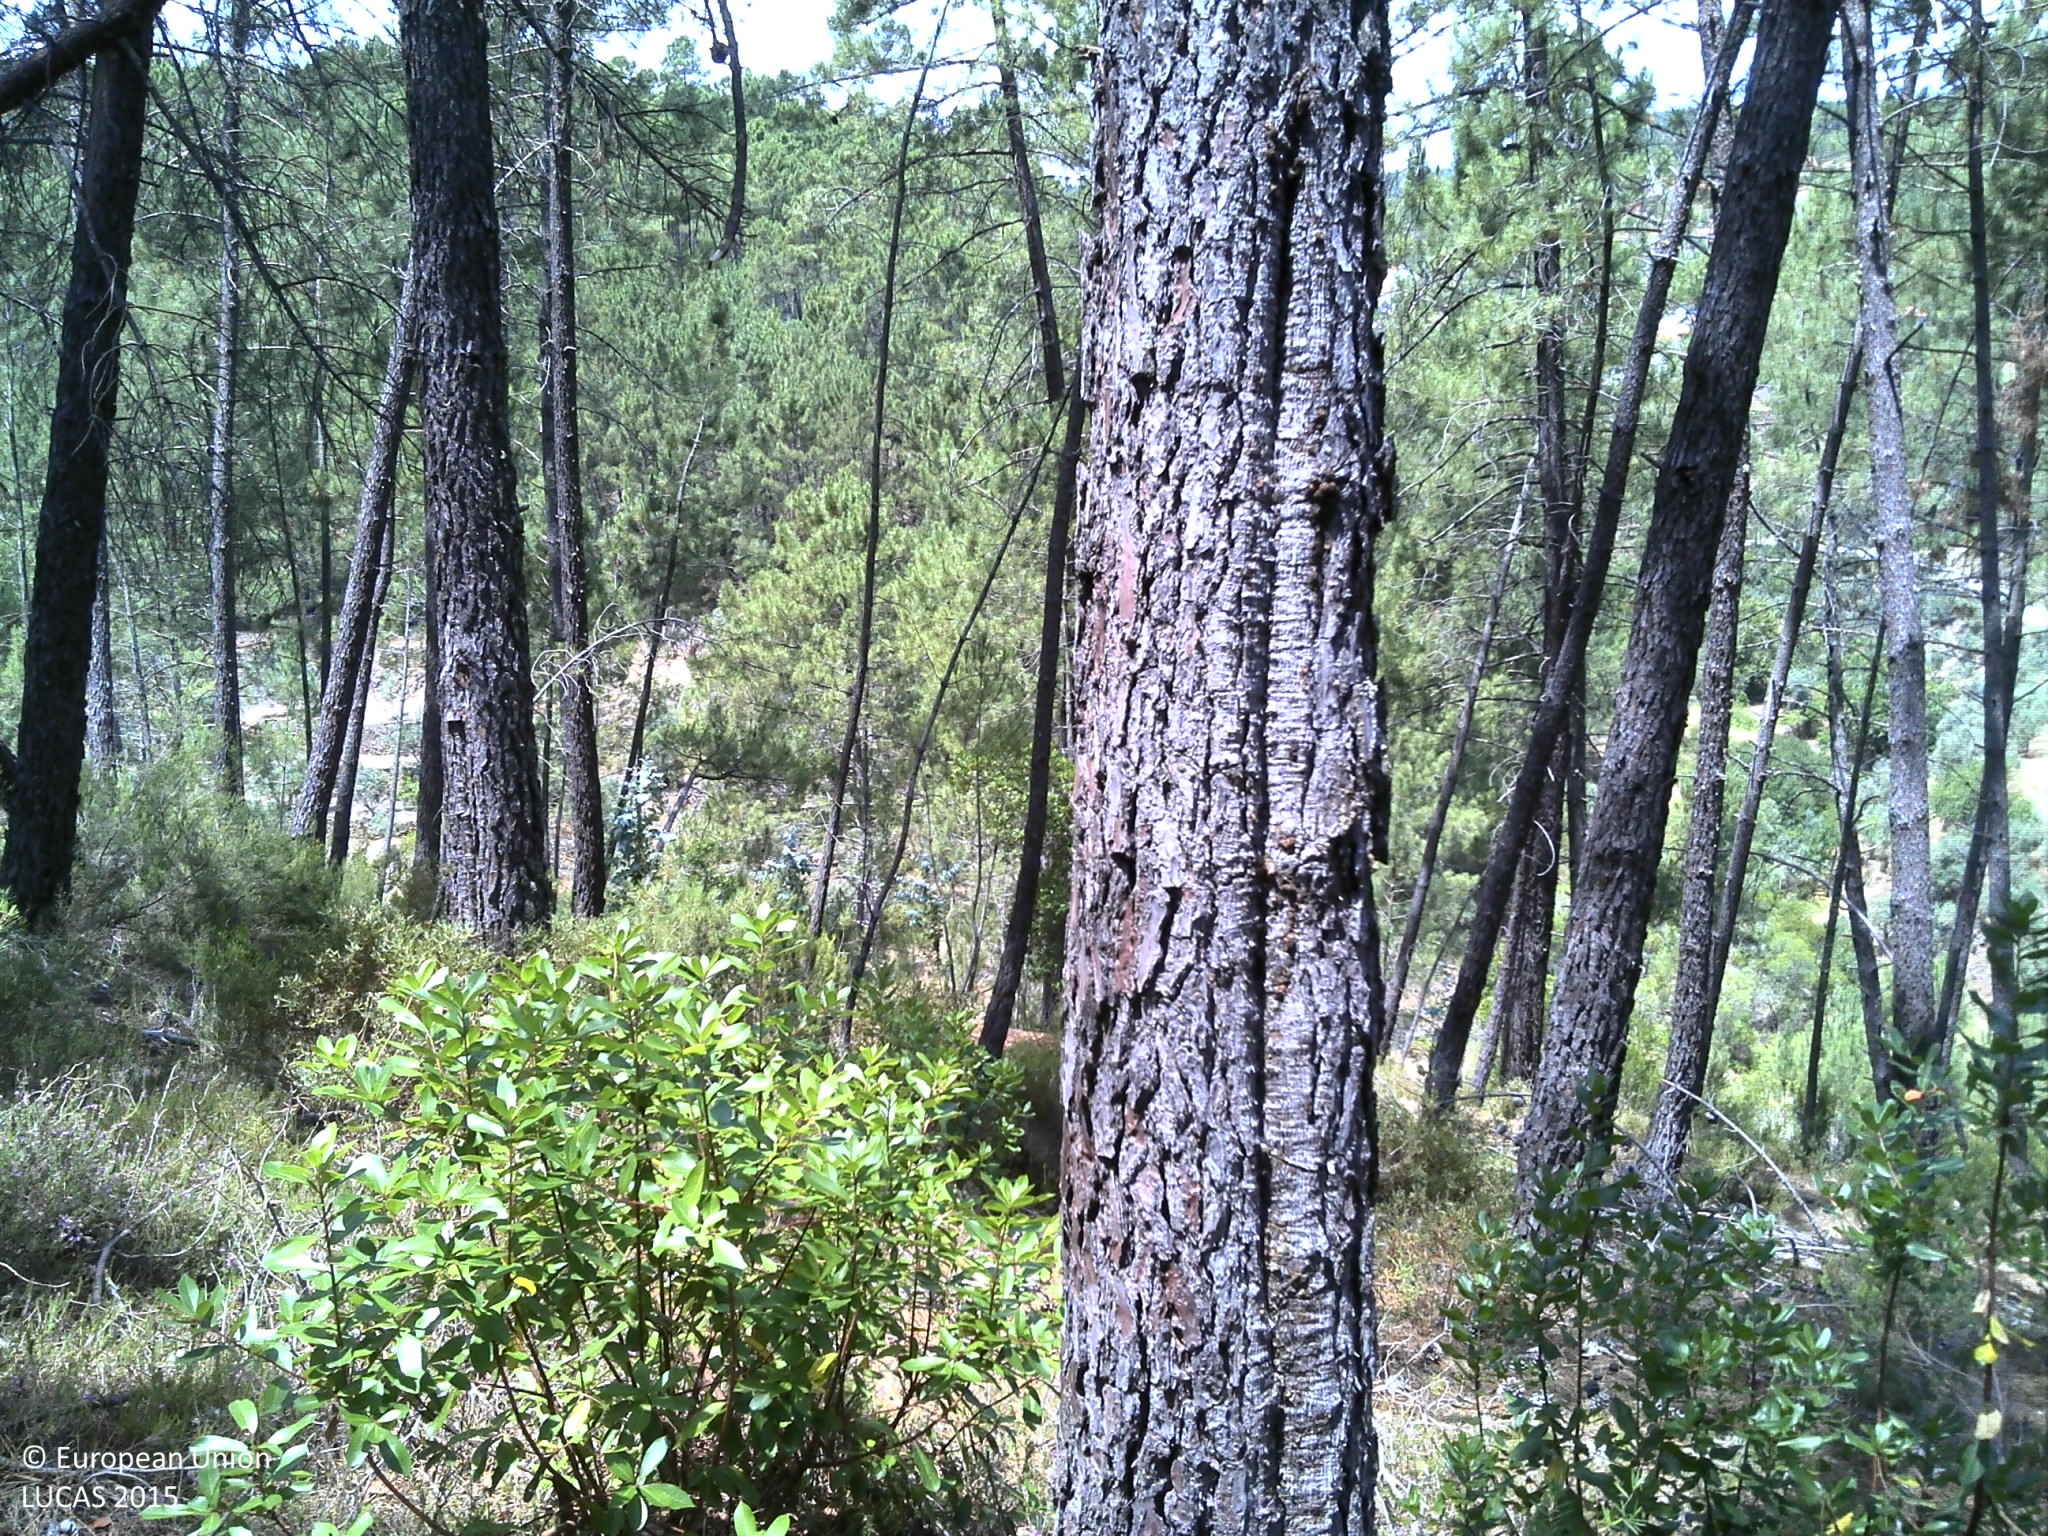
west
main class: Woodland
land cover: Pine dominated coniferous woodland
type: coniferous forest of the mediterranean region
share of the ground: 10 - 25 %
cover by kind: shrubs 50 %, unconsolidated bare surface 35 %, coniferous forest trees 15 %
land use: Forestry
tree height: > 5 m
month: July
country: PT
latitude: 39.8768
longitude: -7.8220
